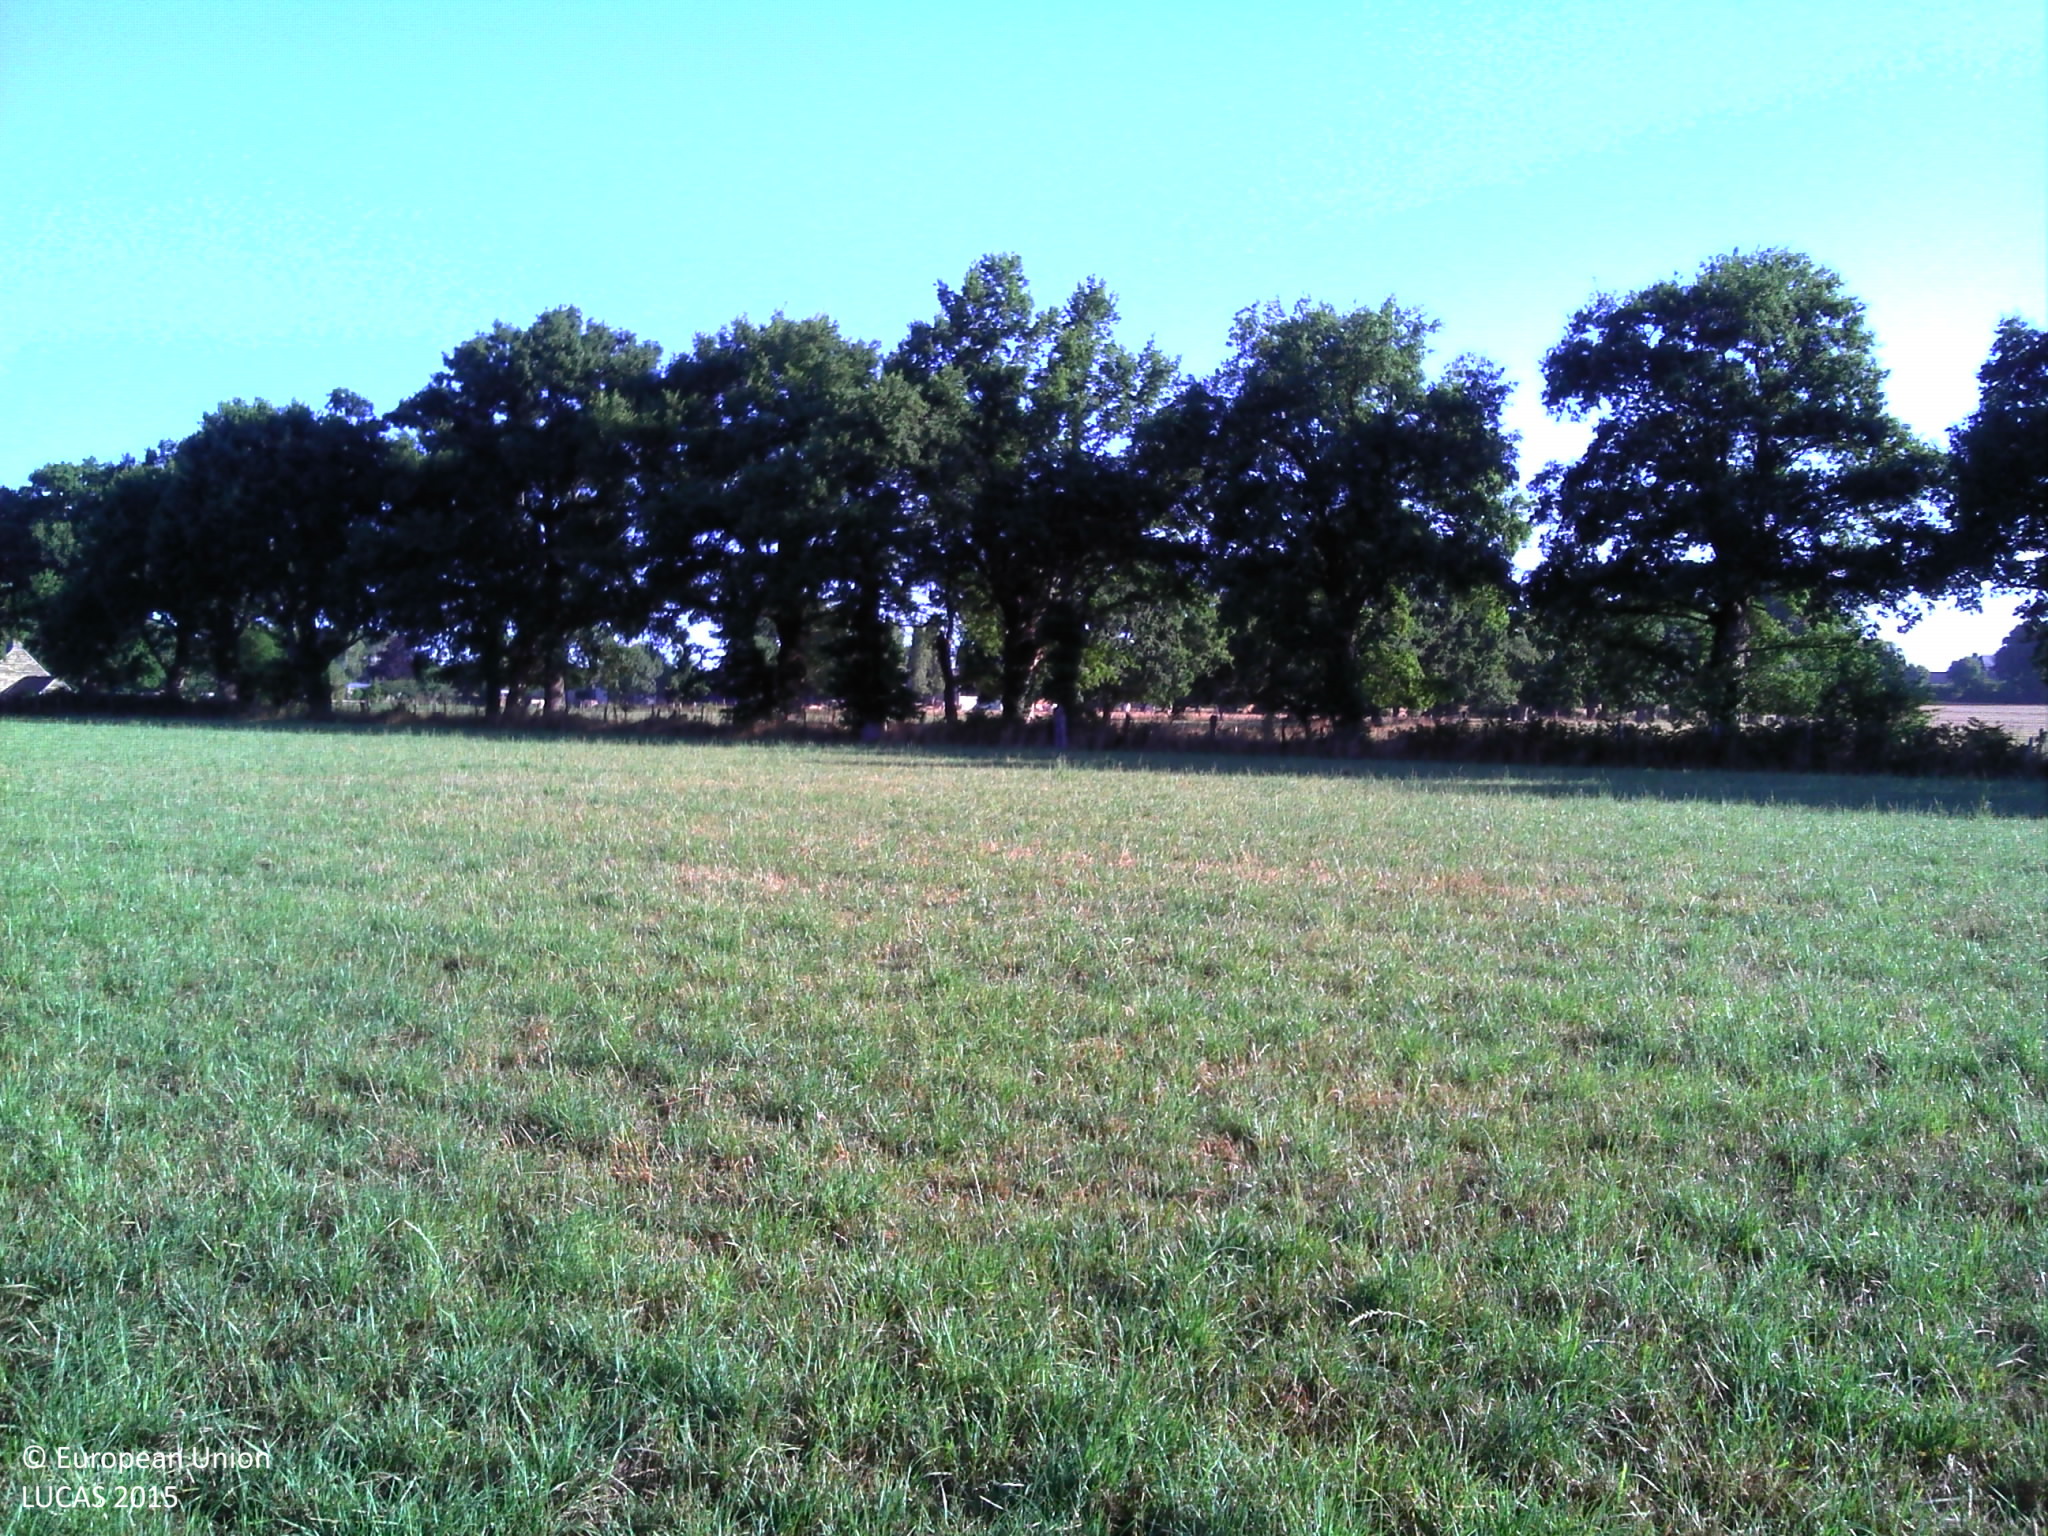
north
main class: Cropland
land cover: Temporary grasslands
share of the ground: > 75 %
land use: Agriculture (excluding fallow land and kitchen gardens)
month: July
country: FR
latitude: 47.6261
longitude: -1.6086
